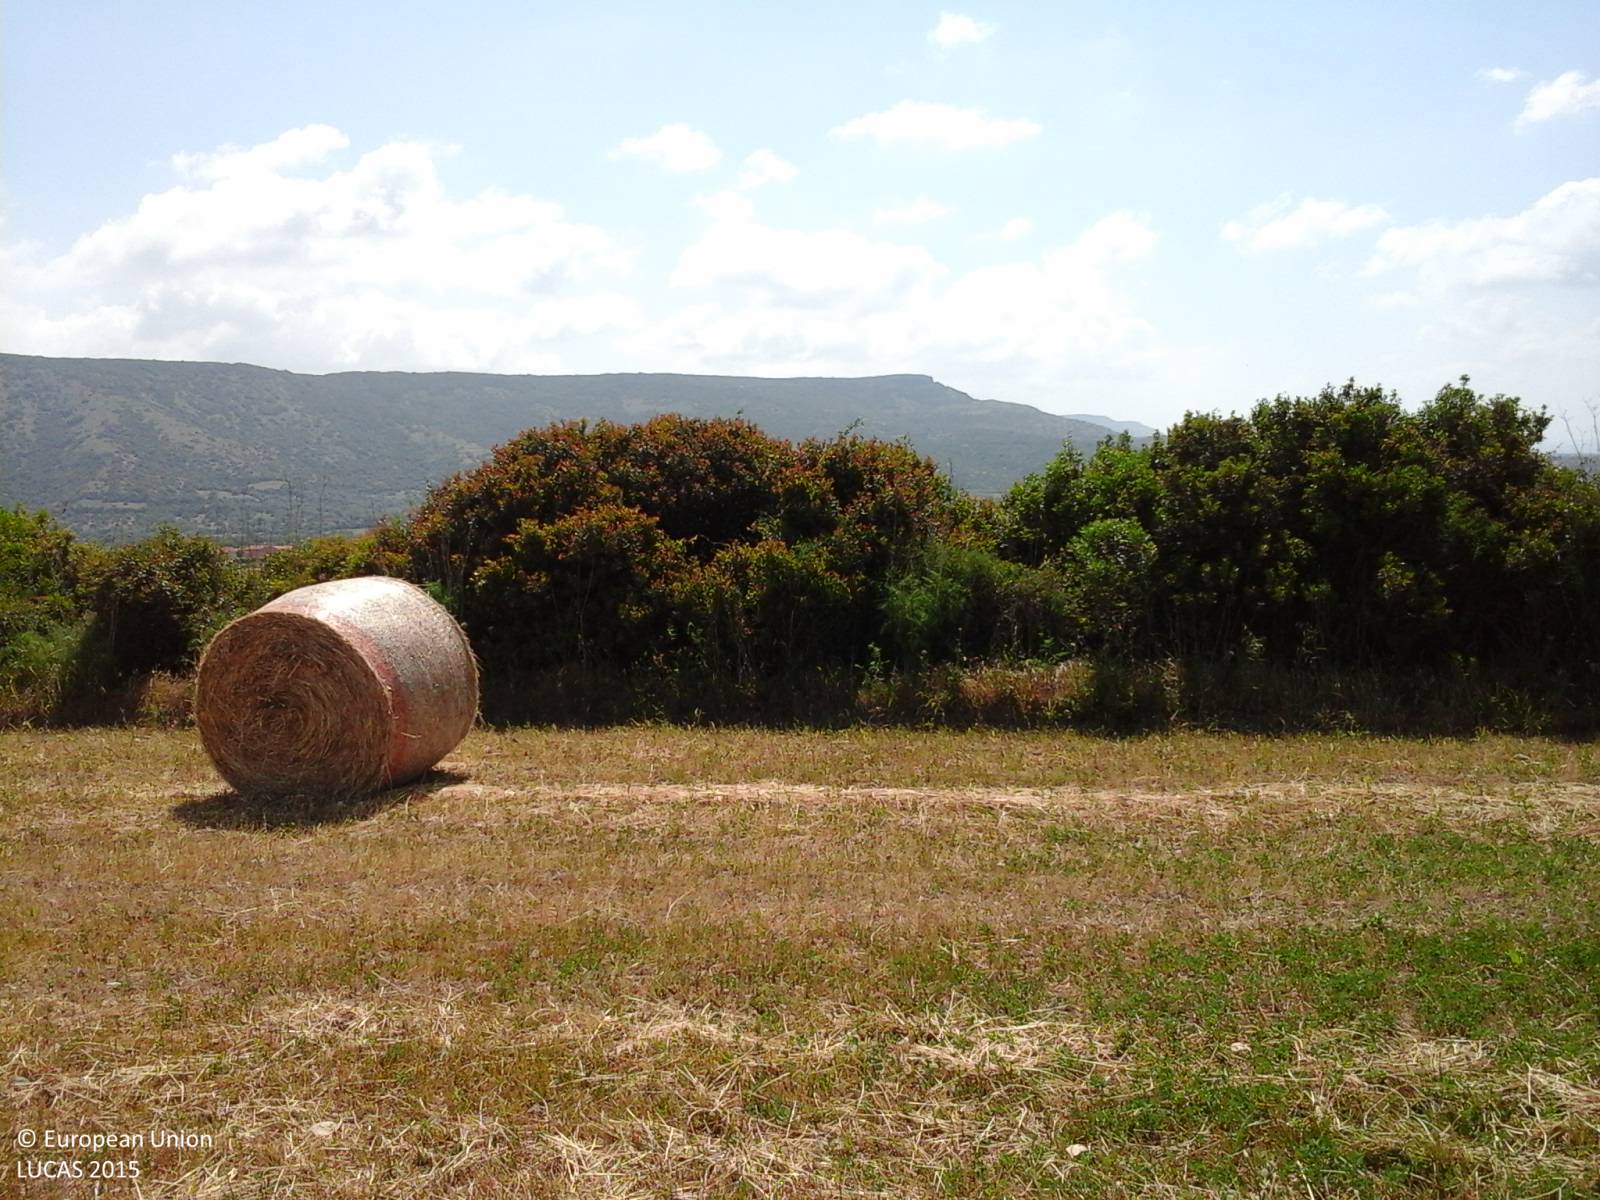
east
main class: Cropland
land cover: Temporary grasslands
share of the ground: > 75 %
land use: Agriculture (excluding fallow land and kitchen gardens)
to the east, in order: Temporary grasslands; Shrubland without tree cover; Clovers; Other fruit trees and berries; Tracks; Electric lines; Grass margins; Grassland without tree/shrub cover; Shrubland without tree cover; Durum wheat
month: May
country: IT
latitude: 39.7898
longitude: 8.8504
